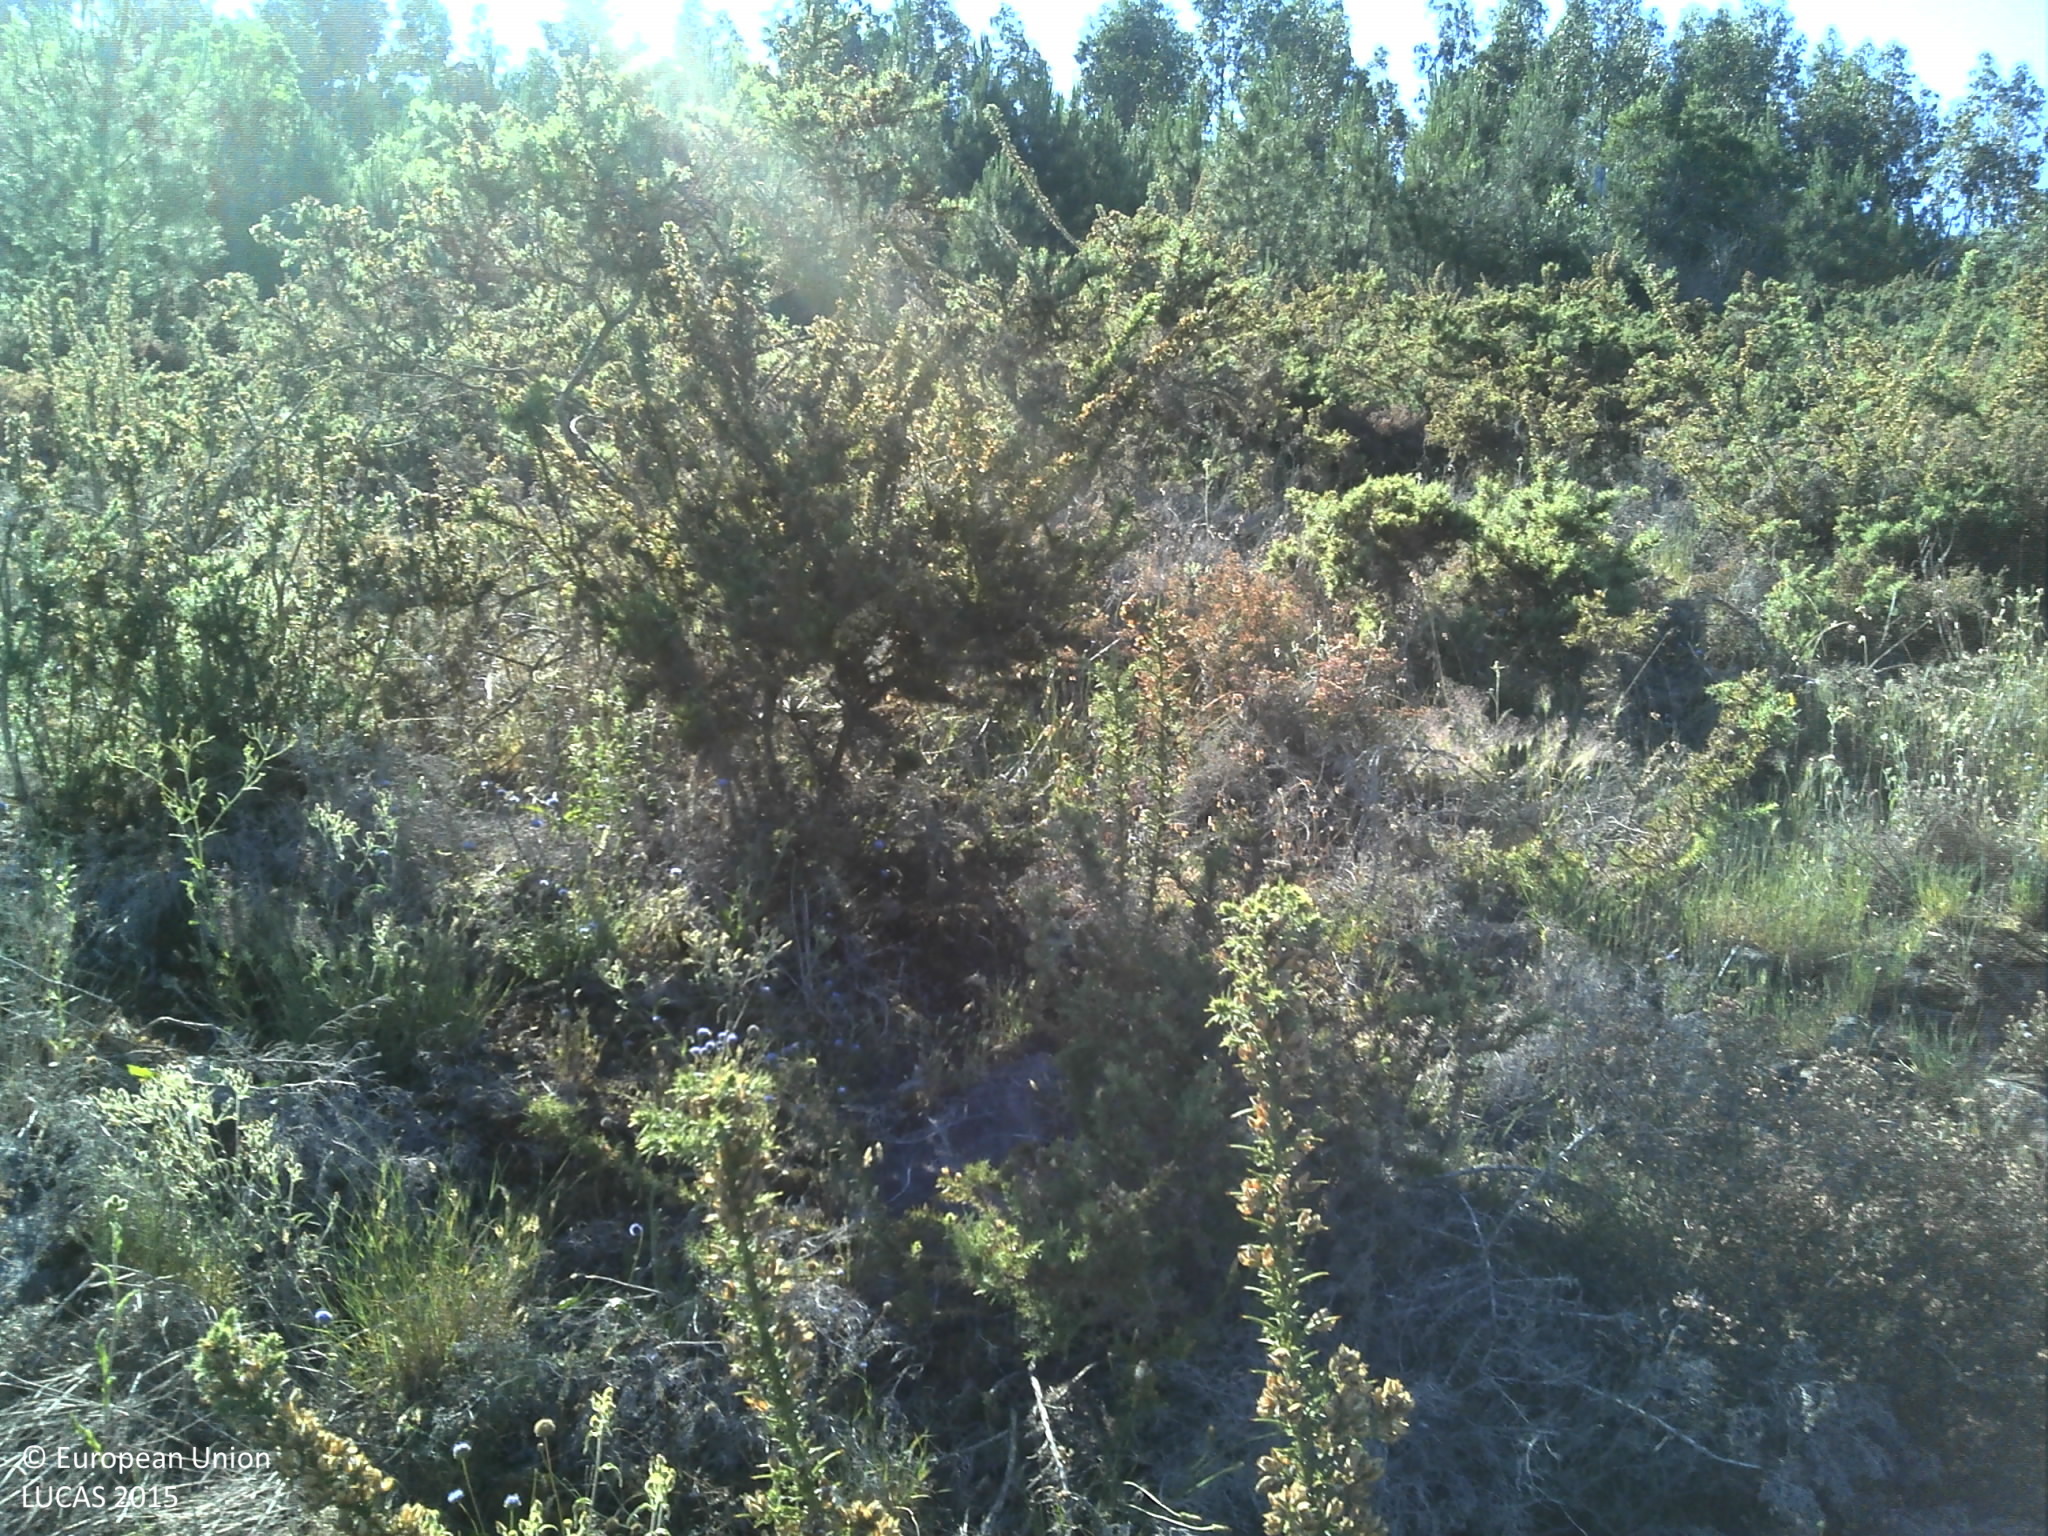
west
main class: Shrubland
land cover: Shrubland without tree cover
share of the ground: > 75 %
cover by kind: shrubs 80 %, herbaceous plants 10 %, unconsolidated bare surface 10 %
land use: Semi-natural and natural areas not in use
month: May
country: PT
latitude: 41.7542
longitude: -8.6488
